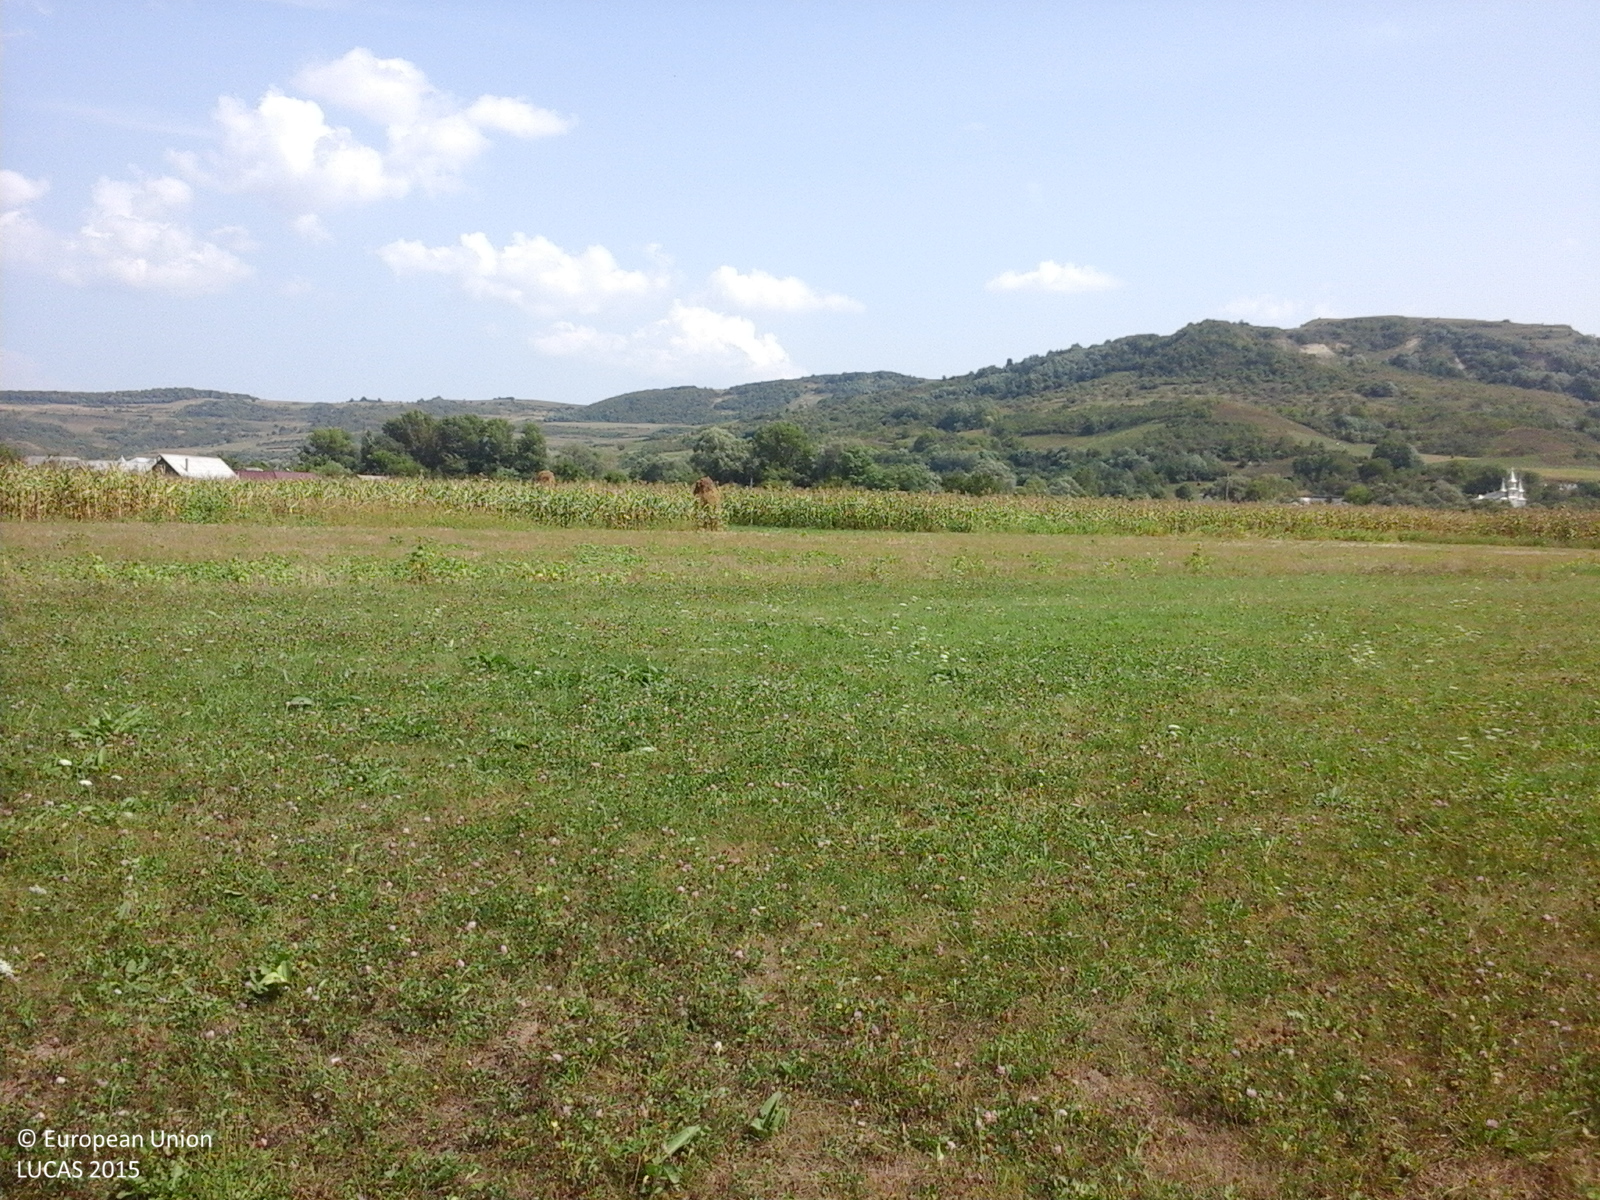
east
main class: Grassland
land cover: Grassland without tree/shrub cover
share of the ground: > 75 %
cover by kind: herbaceous plants 100 %
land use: Agriculture (excluding fallow land and kitchen gardens)
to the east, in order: Grassland without tree/shrub cover; Common wheat; Clovers; Maize; Arable land (only in case pi); Fences; Arable land (only in case pi); Fences; Arable land (only in case pi)
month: September
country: RO
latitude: 47.2317
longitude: 24.1514
